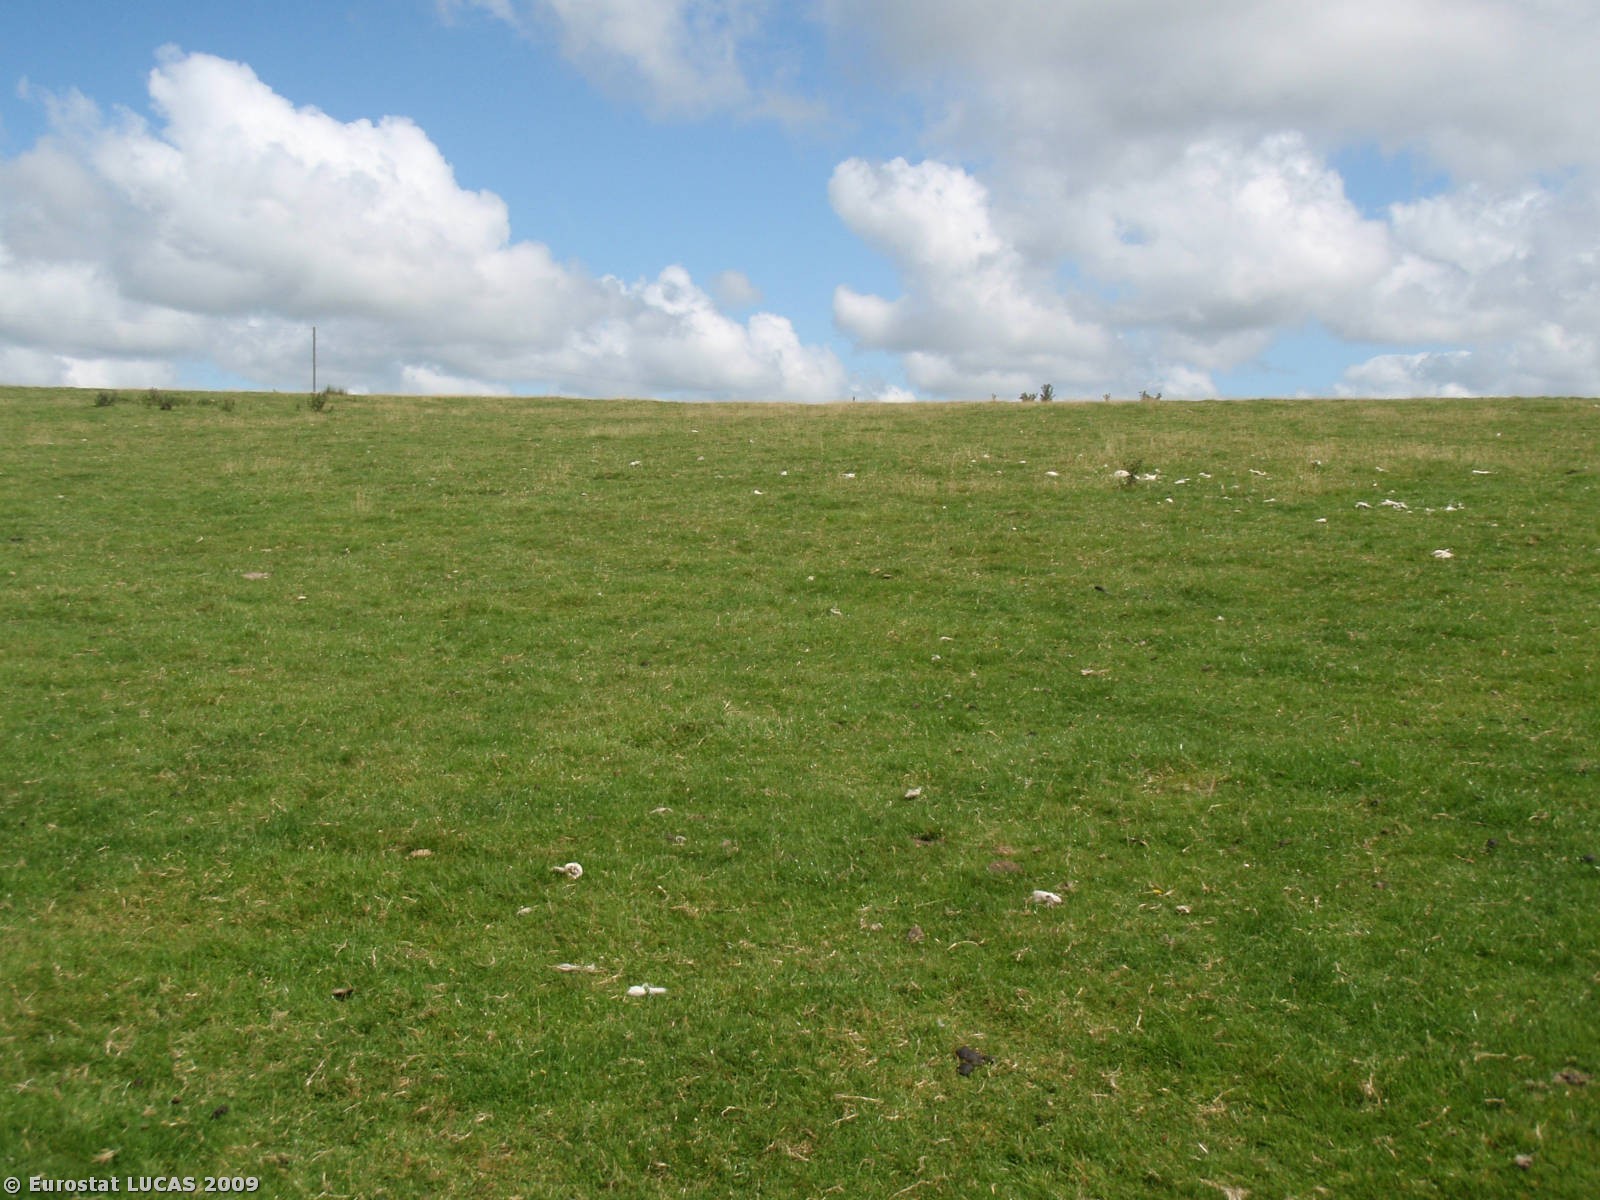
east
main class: Grassland
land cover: Grassland without tree/shrub cover
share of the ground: > 75 %
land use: Agriculture (excluding fallow land and kitchen gardens)
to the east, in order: Grassland without tree/shrub cover; Fences; Dry stone walls; Fences; Grassland with sparse tree/shrub cover; Grassland without tree/shrub cover; Artificial constructions; Single bushes/trees; Grassland without tree/shrub cover; Tracks; Grassland without tree/shrub cover
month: August
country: GB
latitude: 50.5783
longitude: -4.5522
